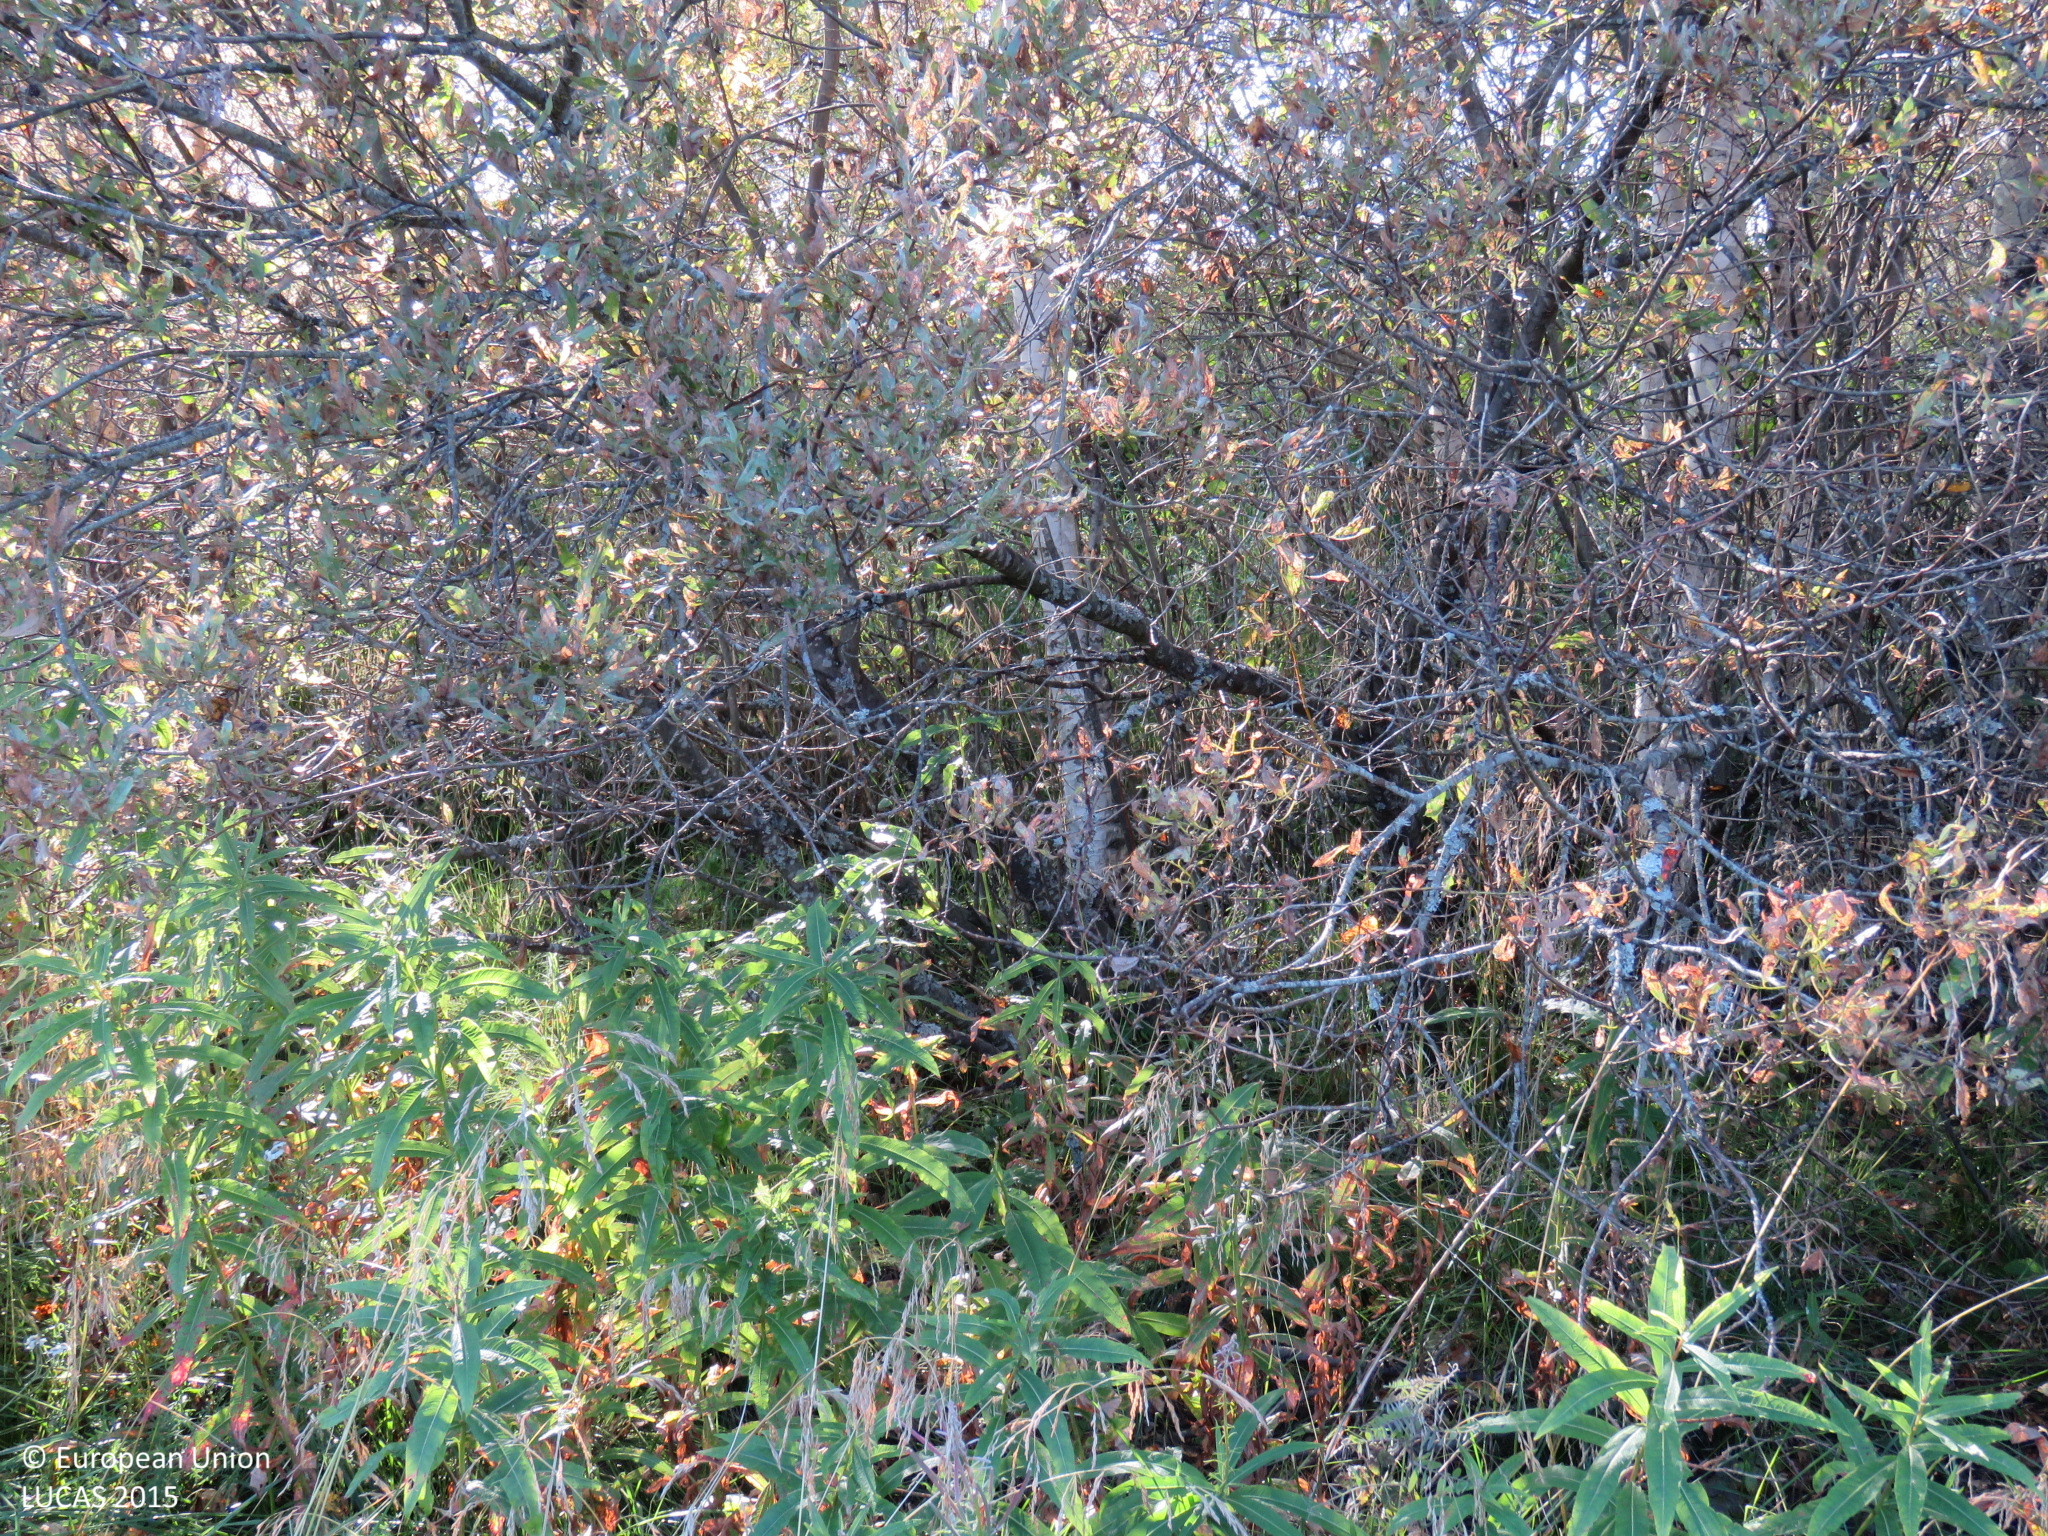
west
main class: Grassland
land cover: Spontaneously vegetated surfaces
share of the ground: > 75 %
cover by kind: herbaceous plants 100 %
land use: Abandoned areas
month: August
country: FI
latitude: 64.8326
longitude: 25.4914
